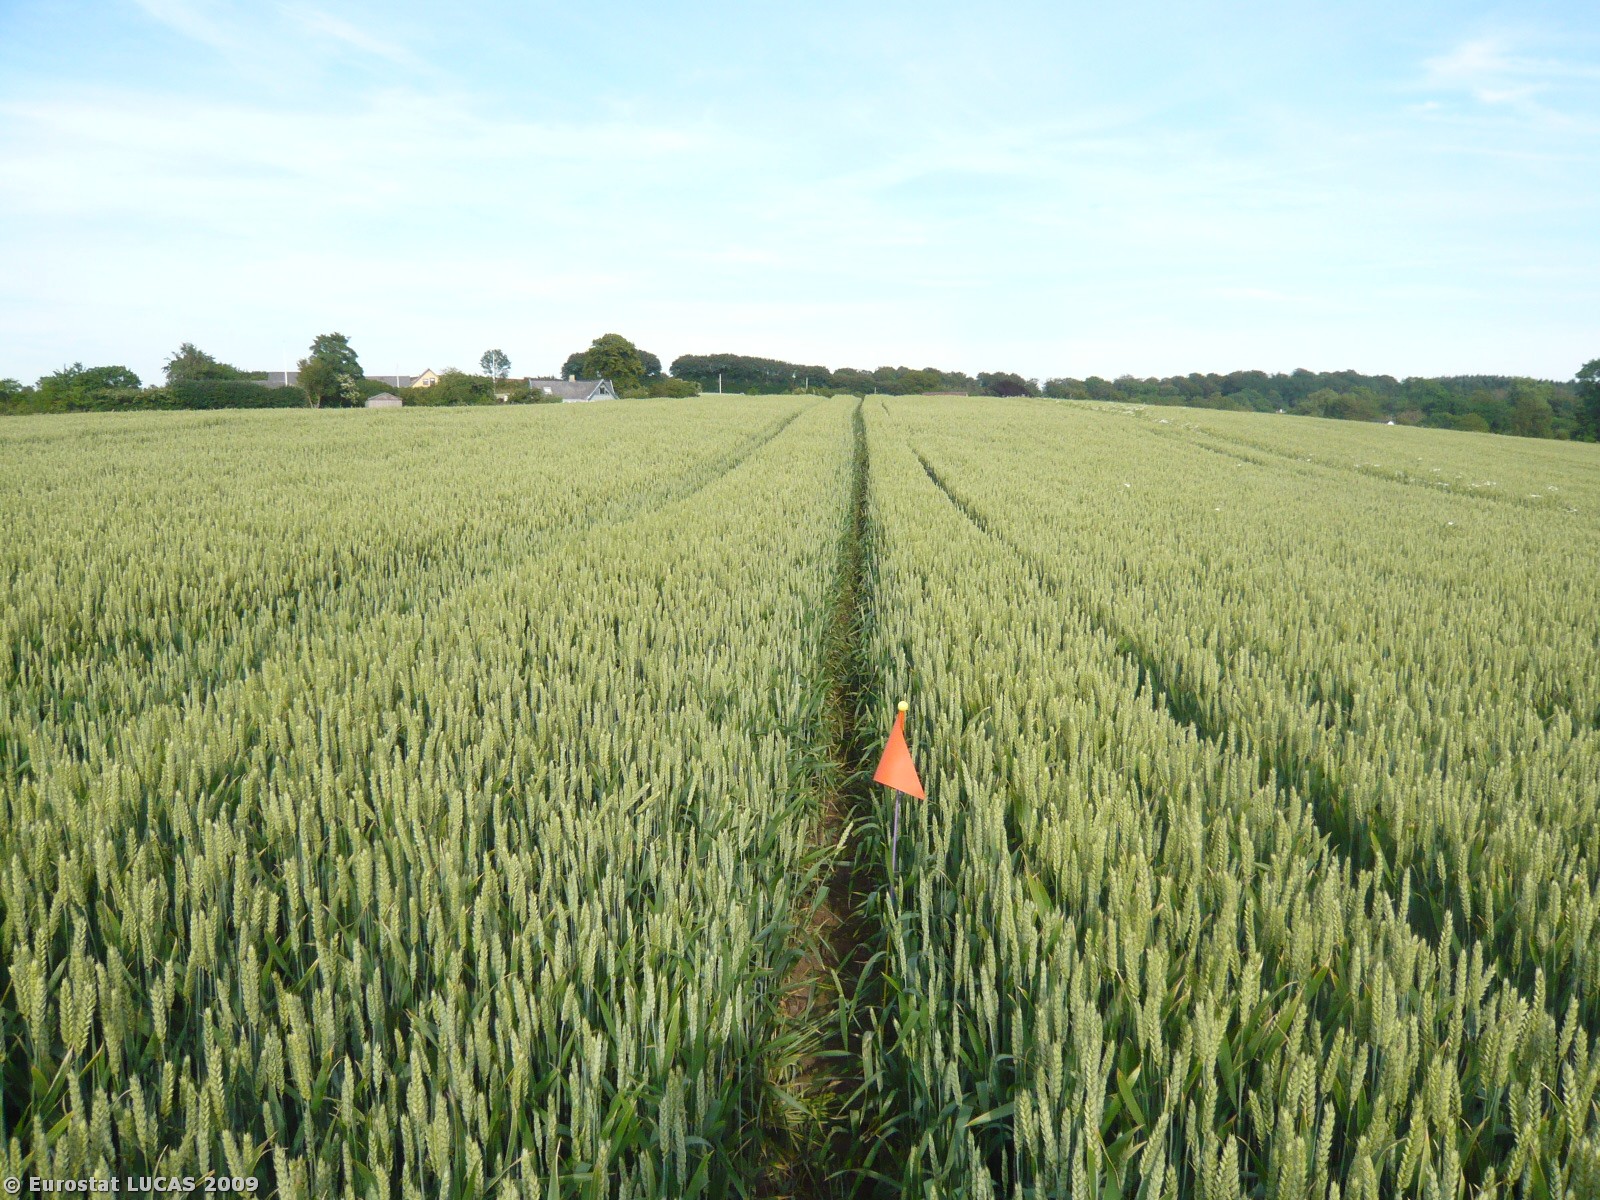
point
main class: Cropland
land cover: Common wheat
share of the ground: > 75 %
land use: Agriculture (excluding fallow land and kitchen gardens)
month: June
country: DK
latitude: 55.1630
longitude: 10.2039
